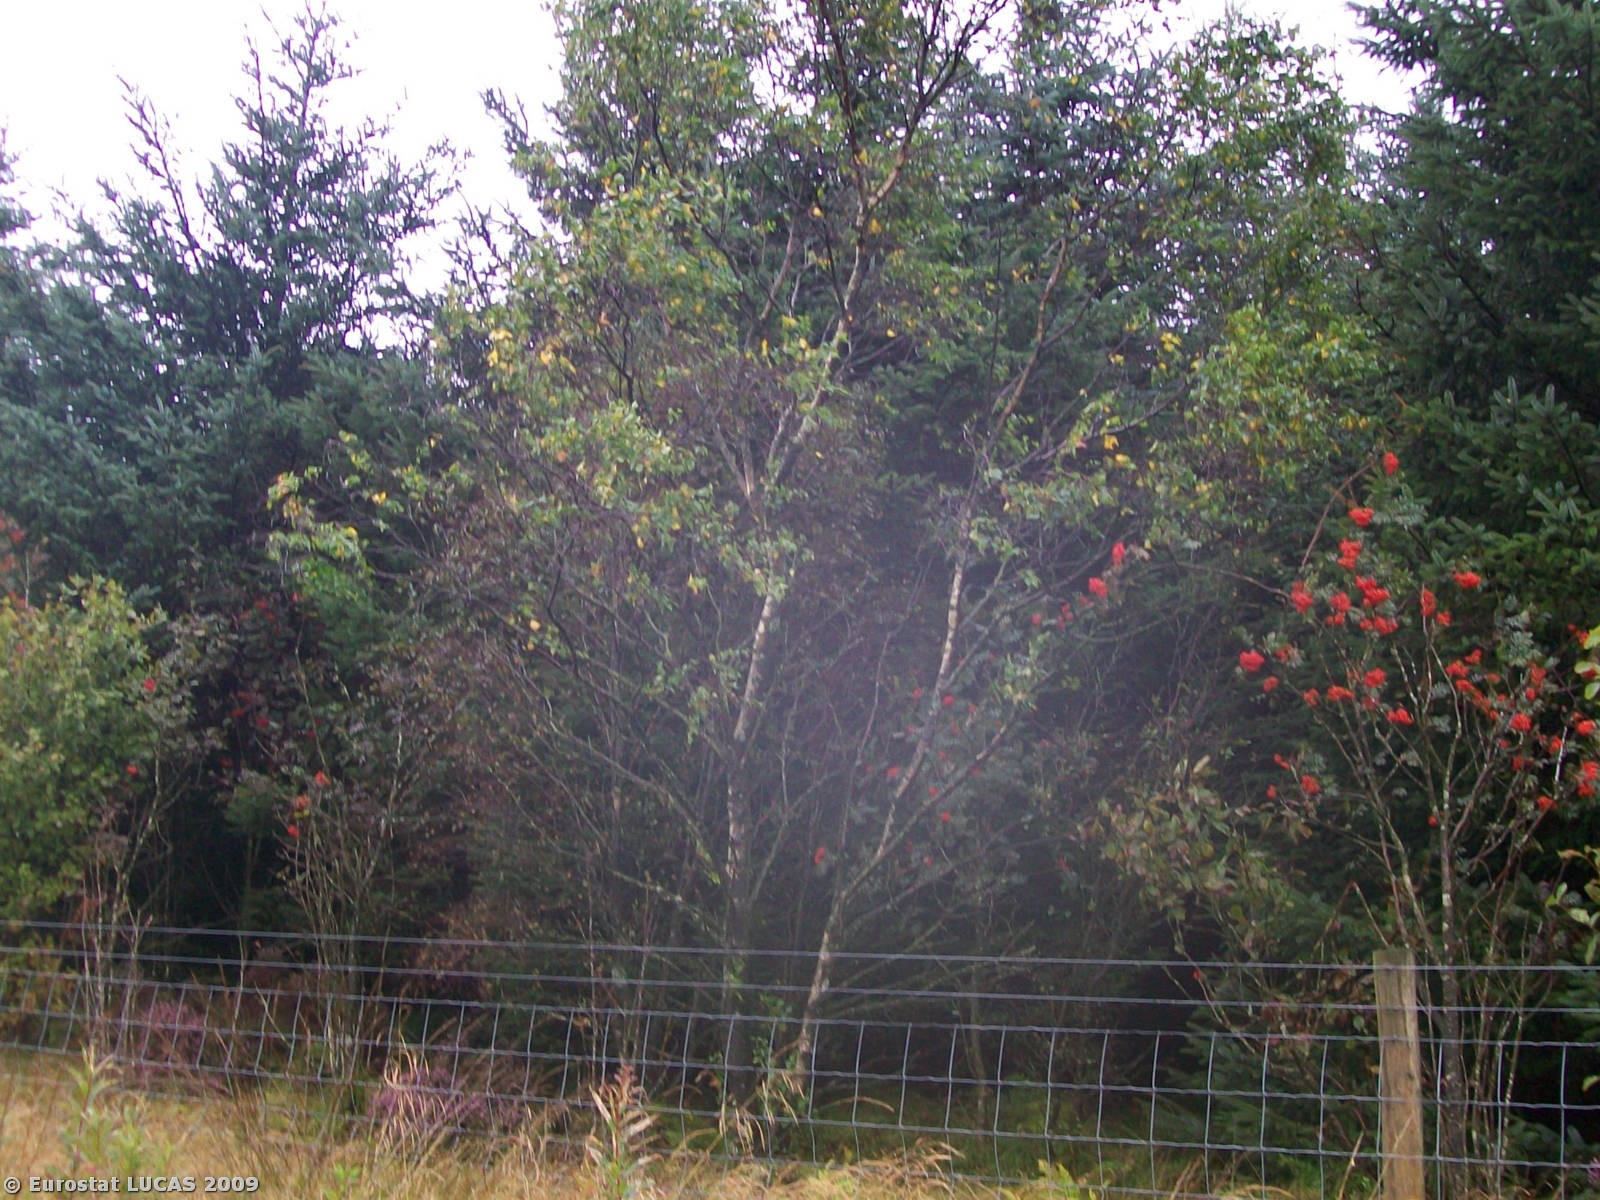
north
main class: Woodland
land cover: Coniferous woodland
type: plantations and self-sown exotic forest
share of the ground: > 75 %
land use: Forestry
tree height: > 5 m
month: August
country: GB
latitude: 54.3382
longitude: -3.1648
